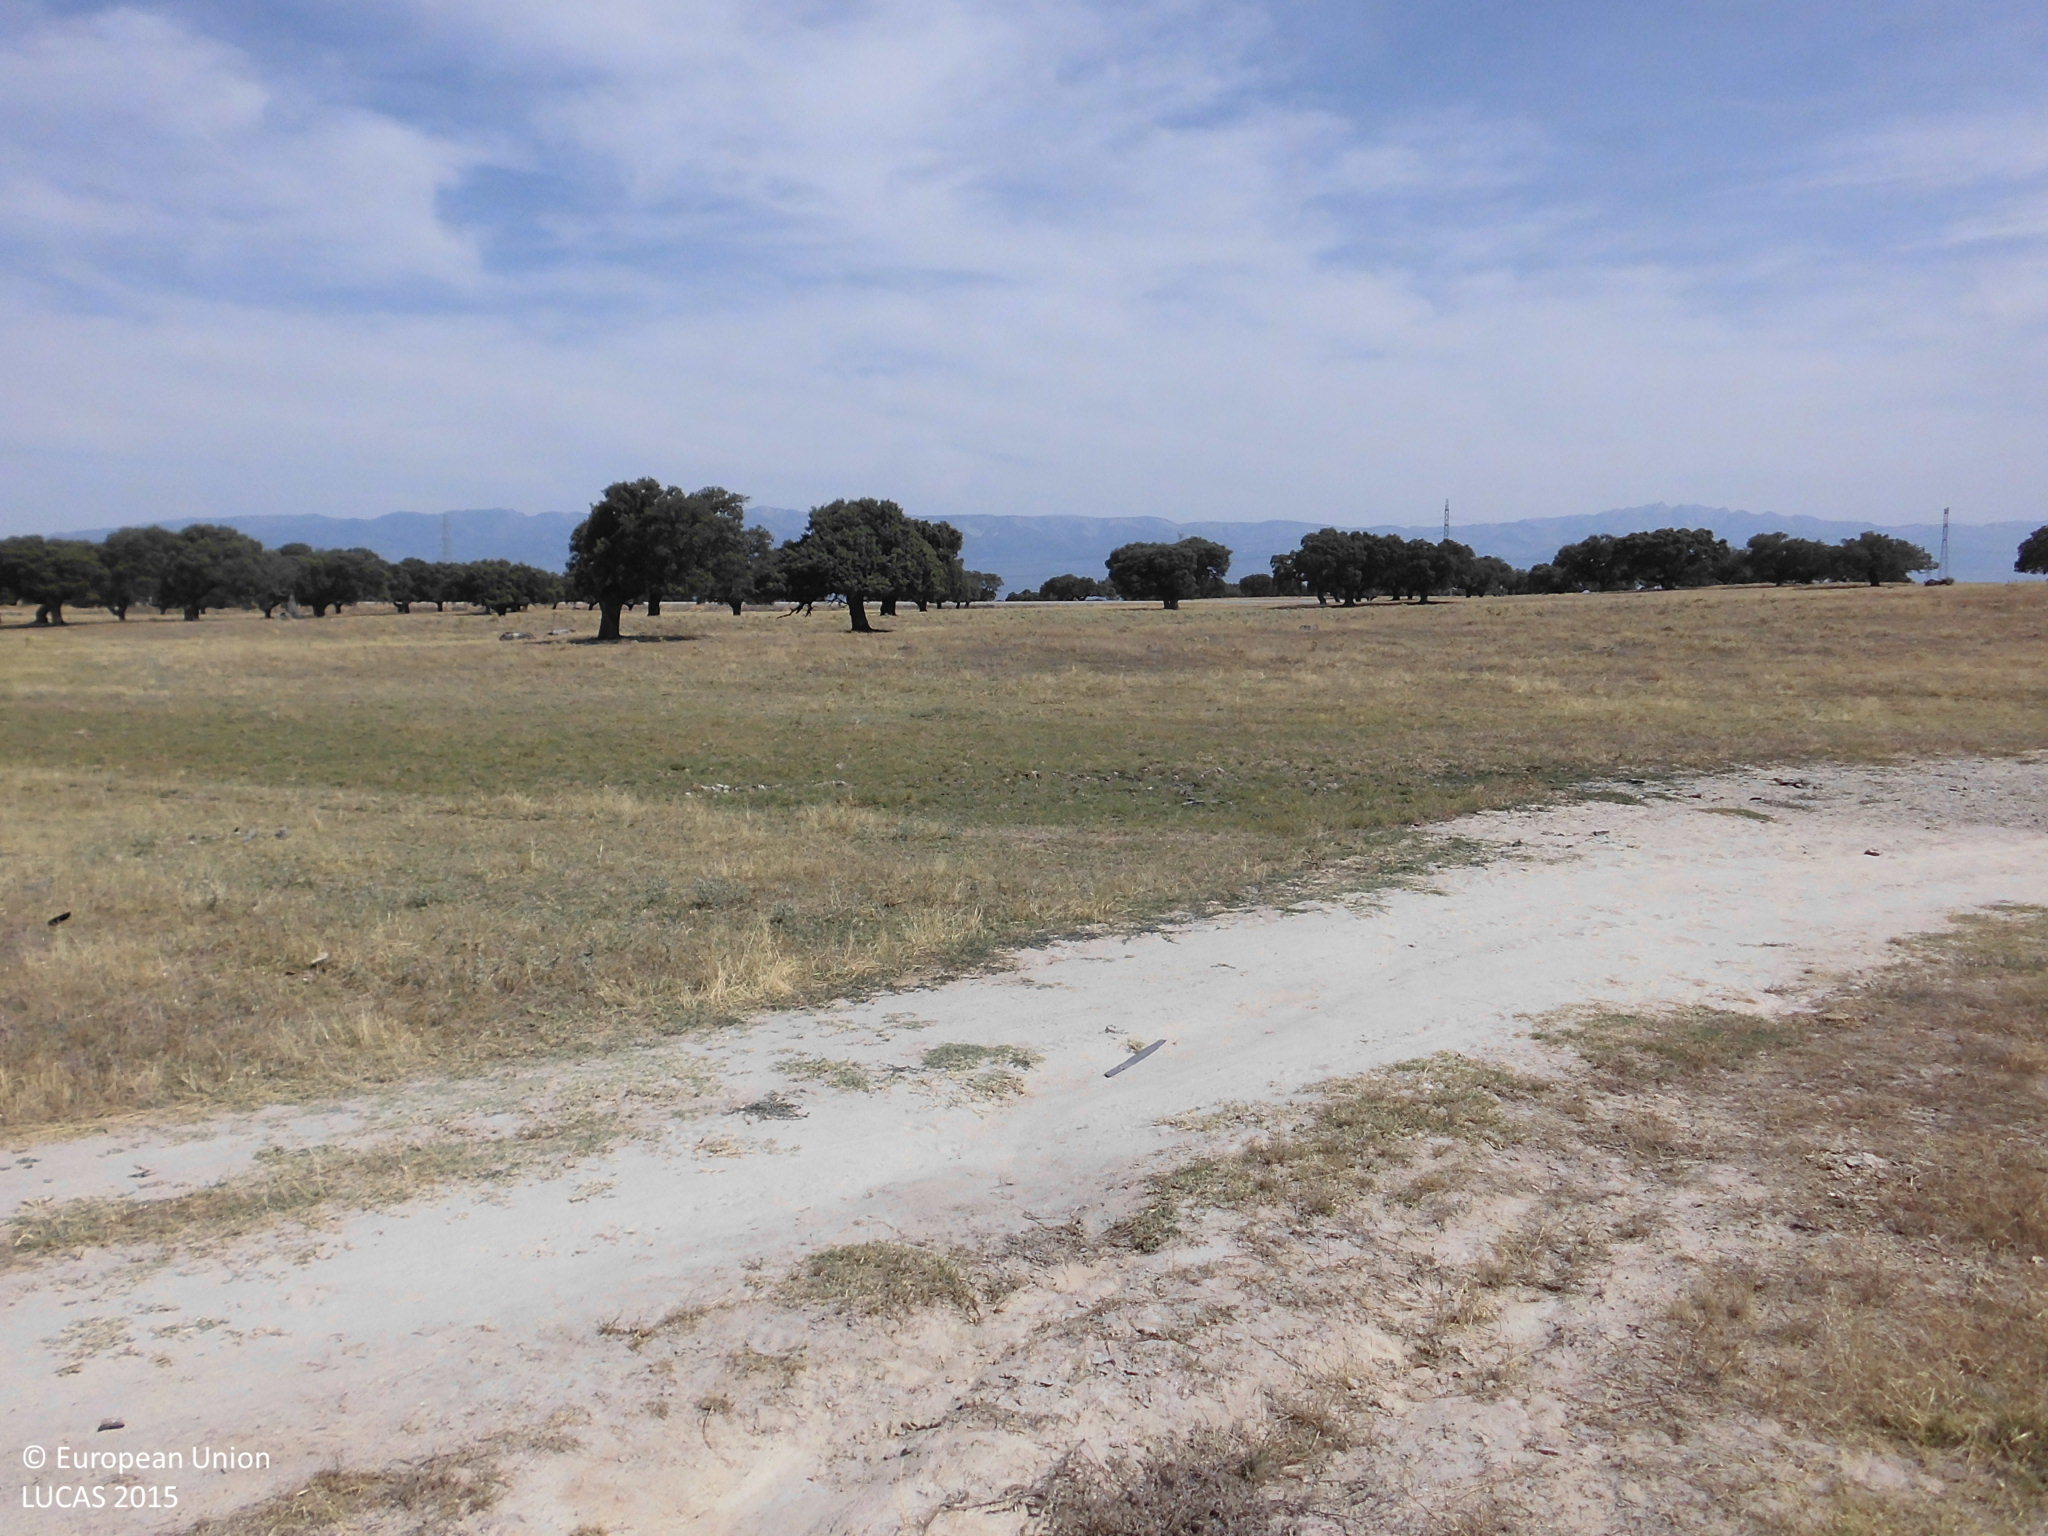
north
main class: Woodland
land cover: Broadleaved woodland
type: broadleaved evergreen forest
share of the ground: 10 - 25 %
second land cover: Grassland without tree/shrub cover
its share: > 75 %
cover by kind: herbaceous plants 85 %, broadleaved forest trees 10 %, unconsolidated bare surface 5 %
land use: Forestry
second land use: Agriculture (excluding fallow land and kitchen gardens)
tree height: > 5 m
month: July
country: ES
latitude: 39.9047
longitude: -5.4150
